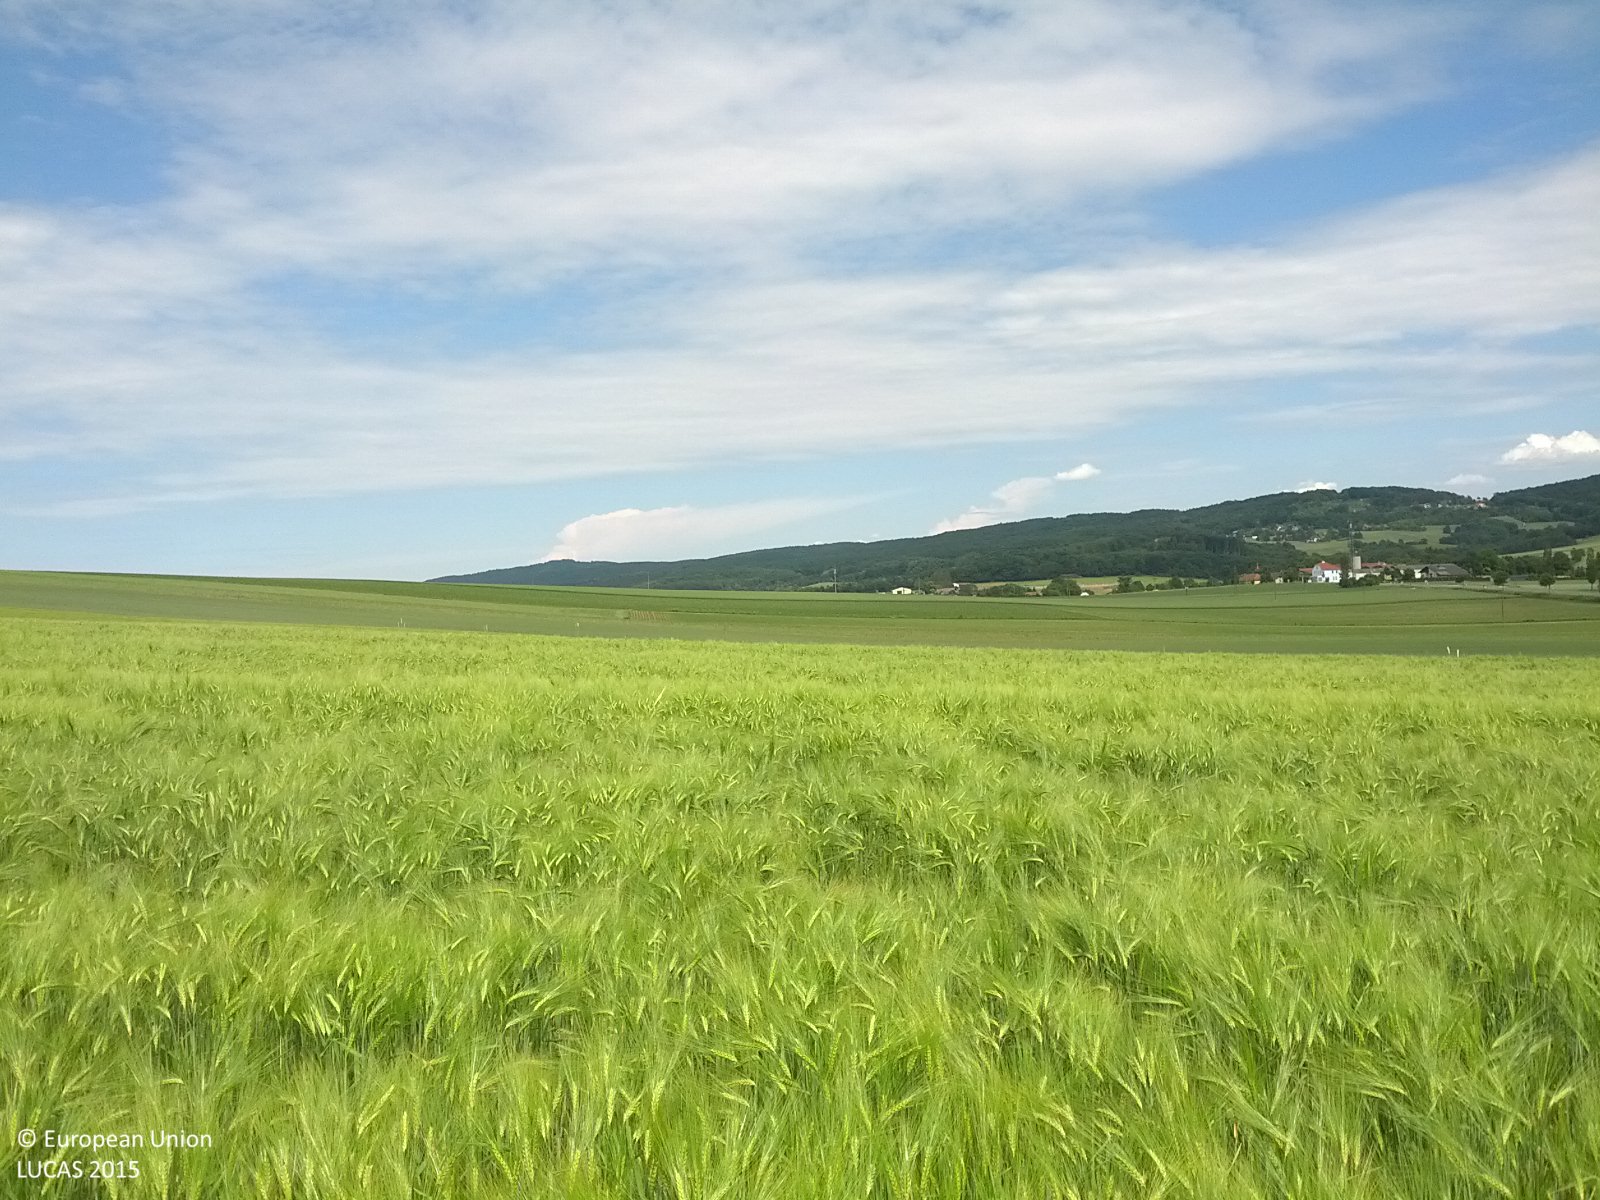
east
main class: Cropland
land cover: Barley
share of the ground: > 75 %
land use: Agriculture (excluding fallow land and kitchen gardens)
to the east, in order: Barley; Durum wheat; Maize; Grass margins; Nurseries; Grass margins; Barley
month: June
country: AT
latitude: 48.2558
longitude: 16.0516
